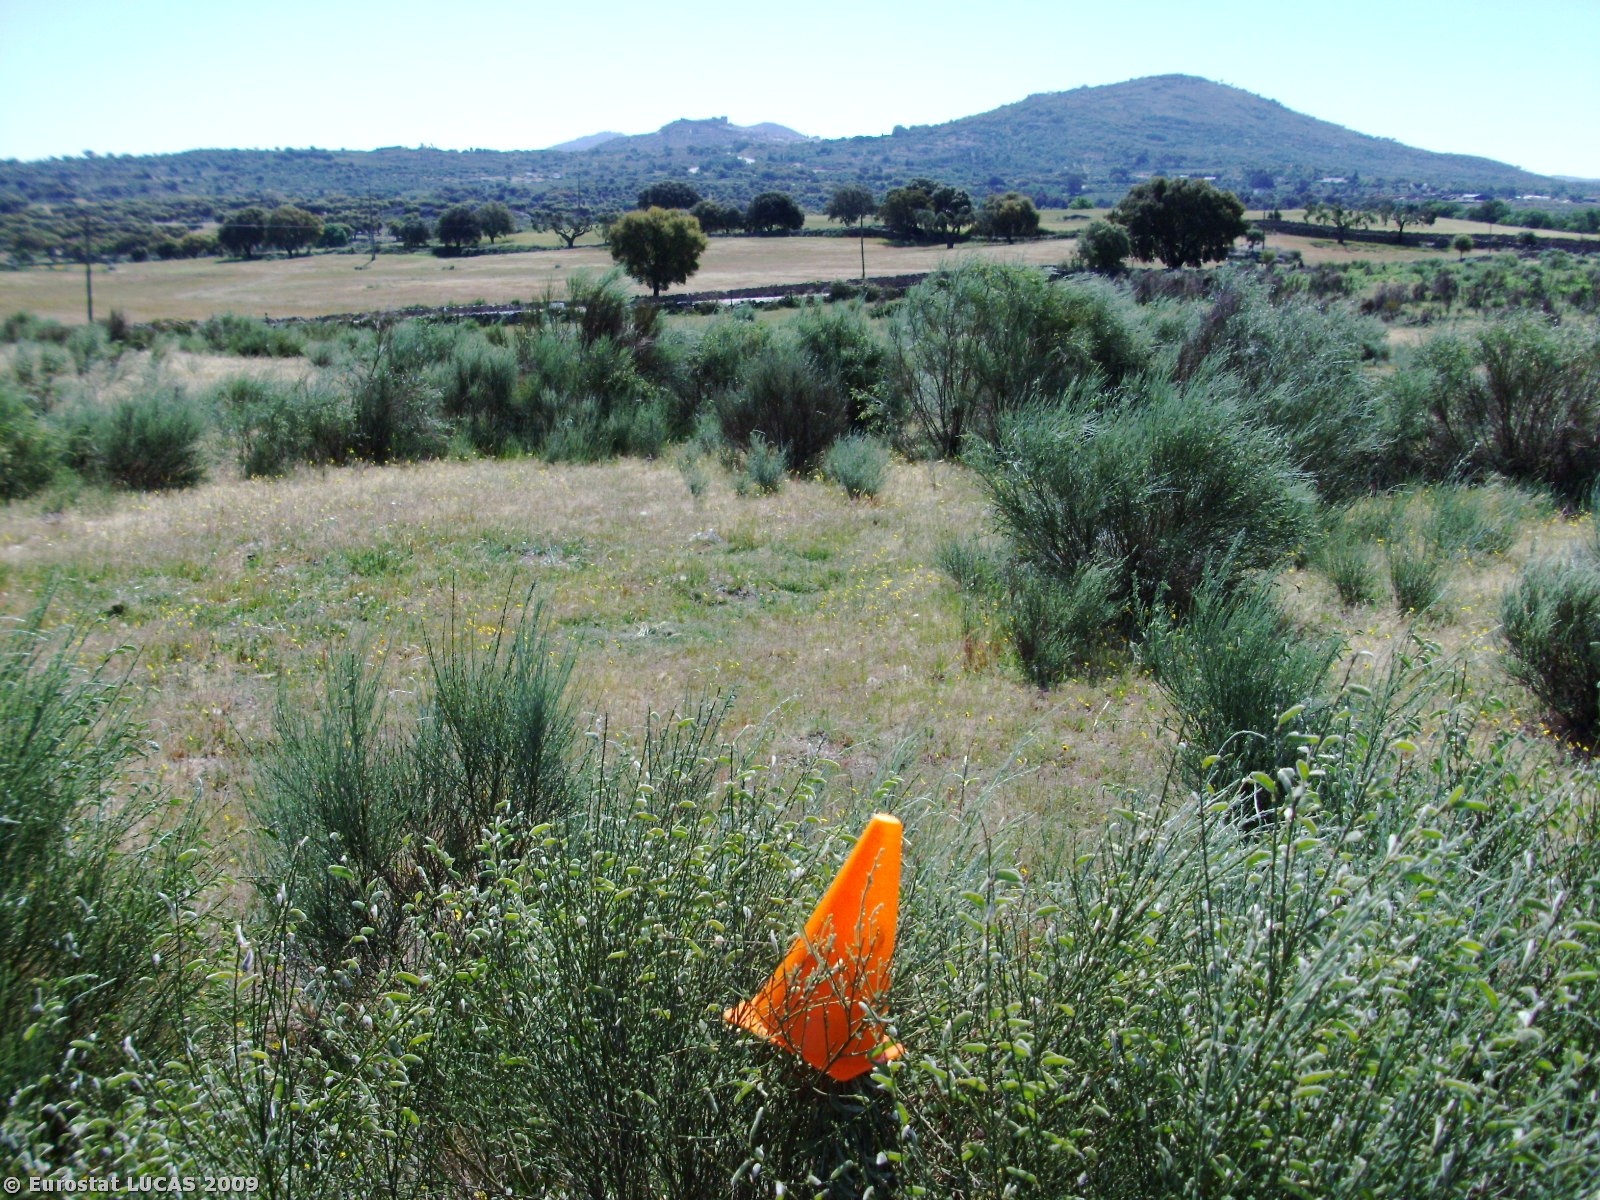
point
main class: Grassland
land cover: Grassland with sparse tree/shrub cover
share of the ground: > 75 %
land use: Agriculture (excluding fallow land and kitchen gardens)
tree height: > 5 m
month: May
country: PT
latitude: 39.4360
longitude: -7.5082
